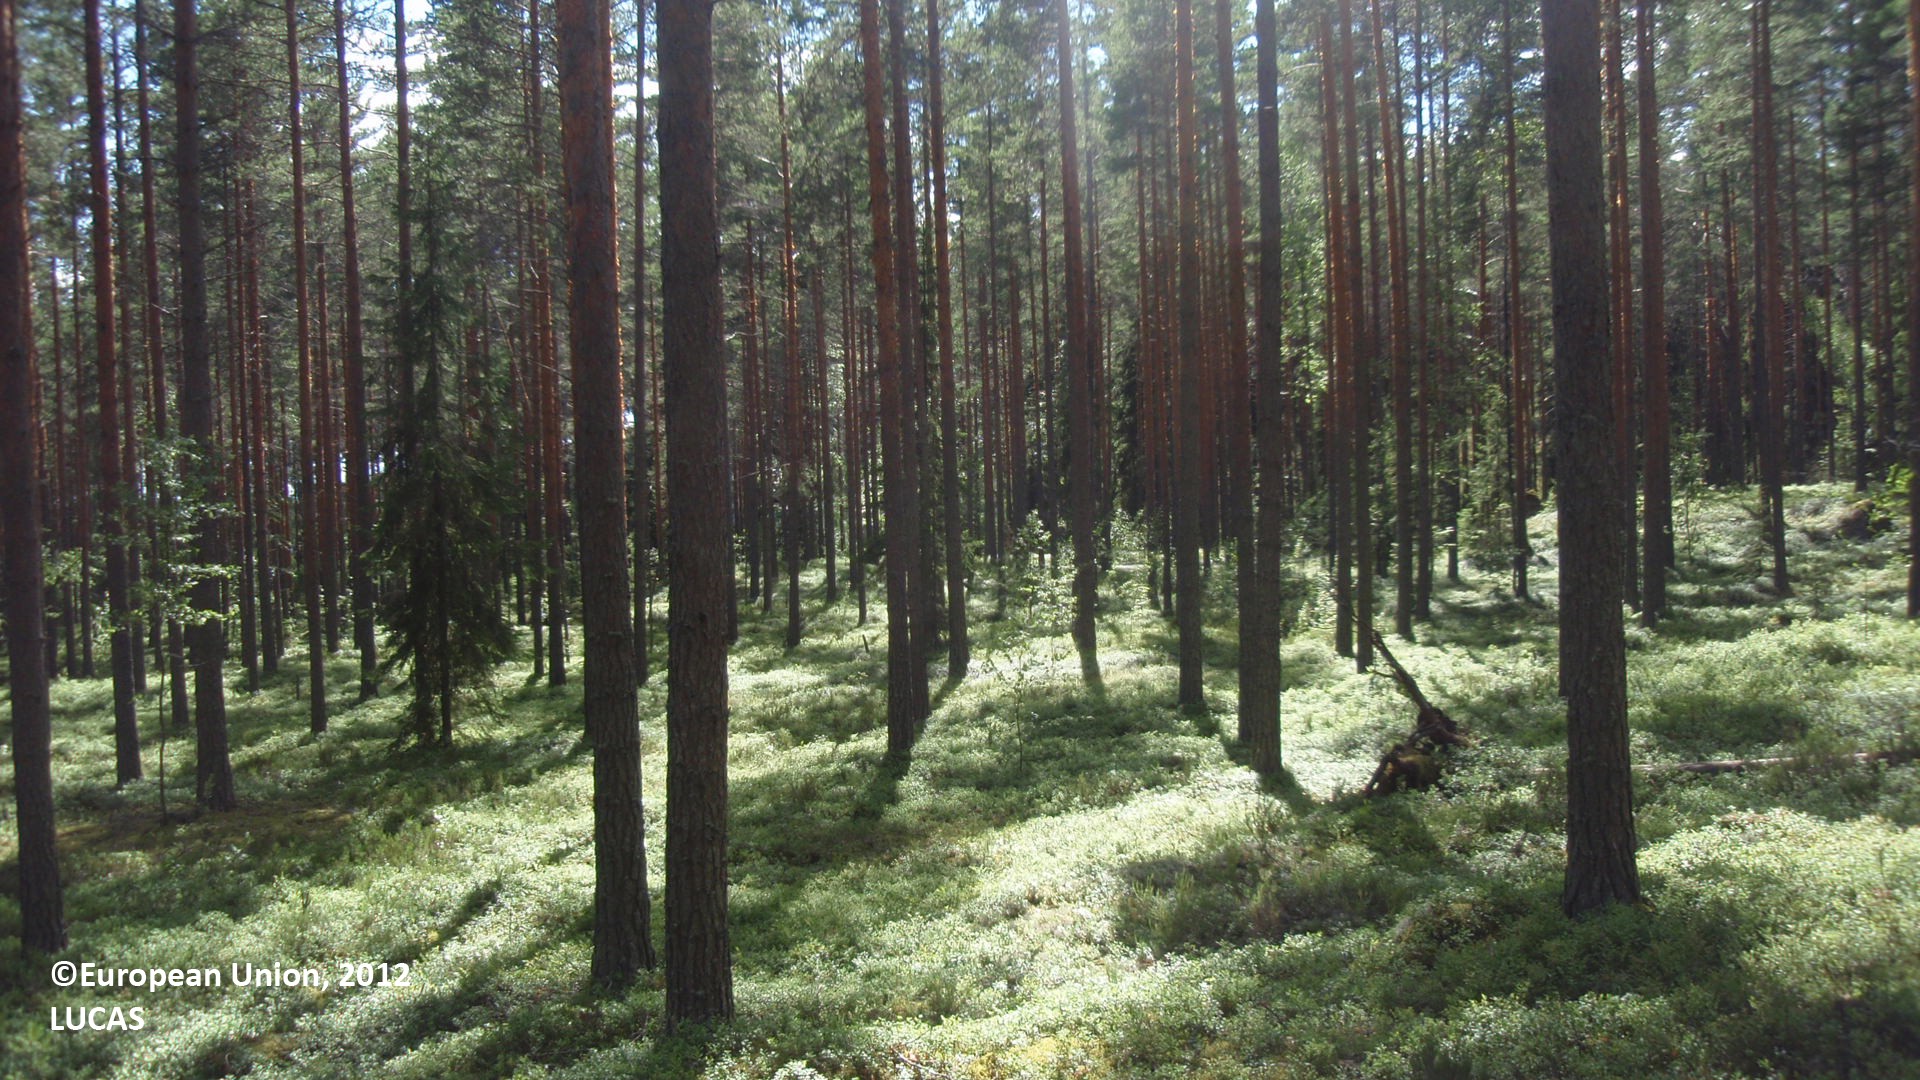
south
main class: Woodland
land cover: Pine dominated coniferous woodland
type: boreal forest
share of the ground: 25 - 50 %
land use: Forestry
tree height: > 5 m
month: July
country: FI
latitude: 61.6618
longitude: 27.8447
